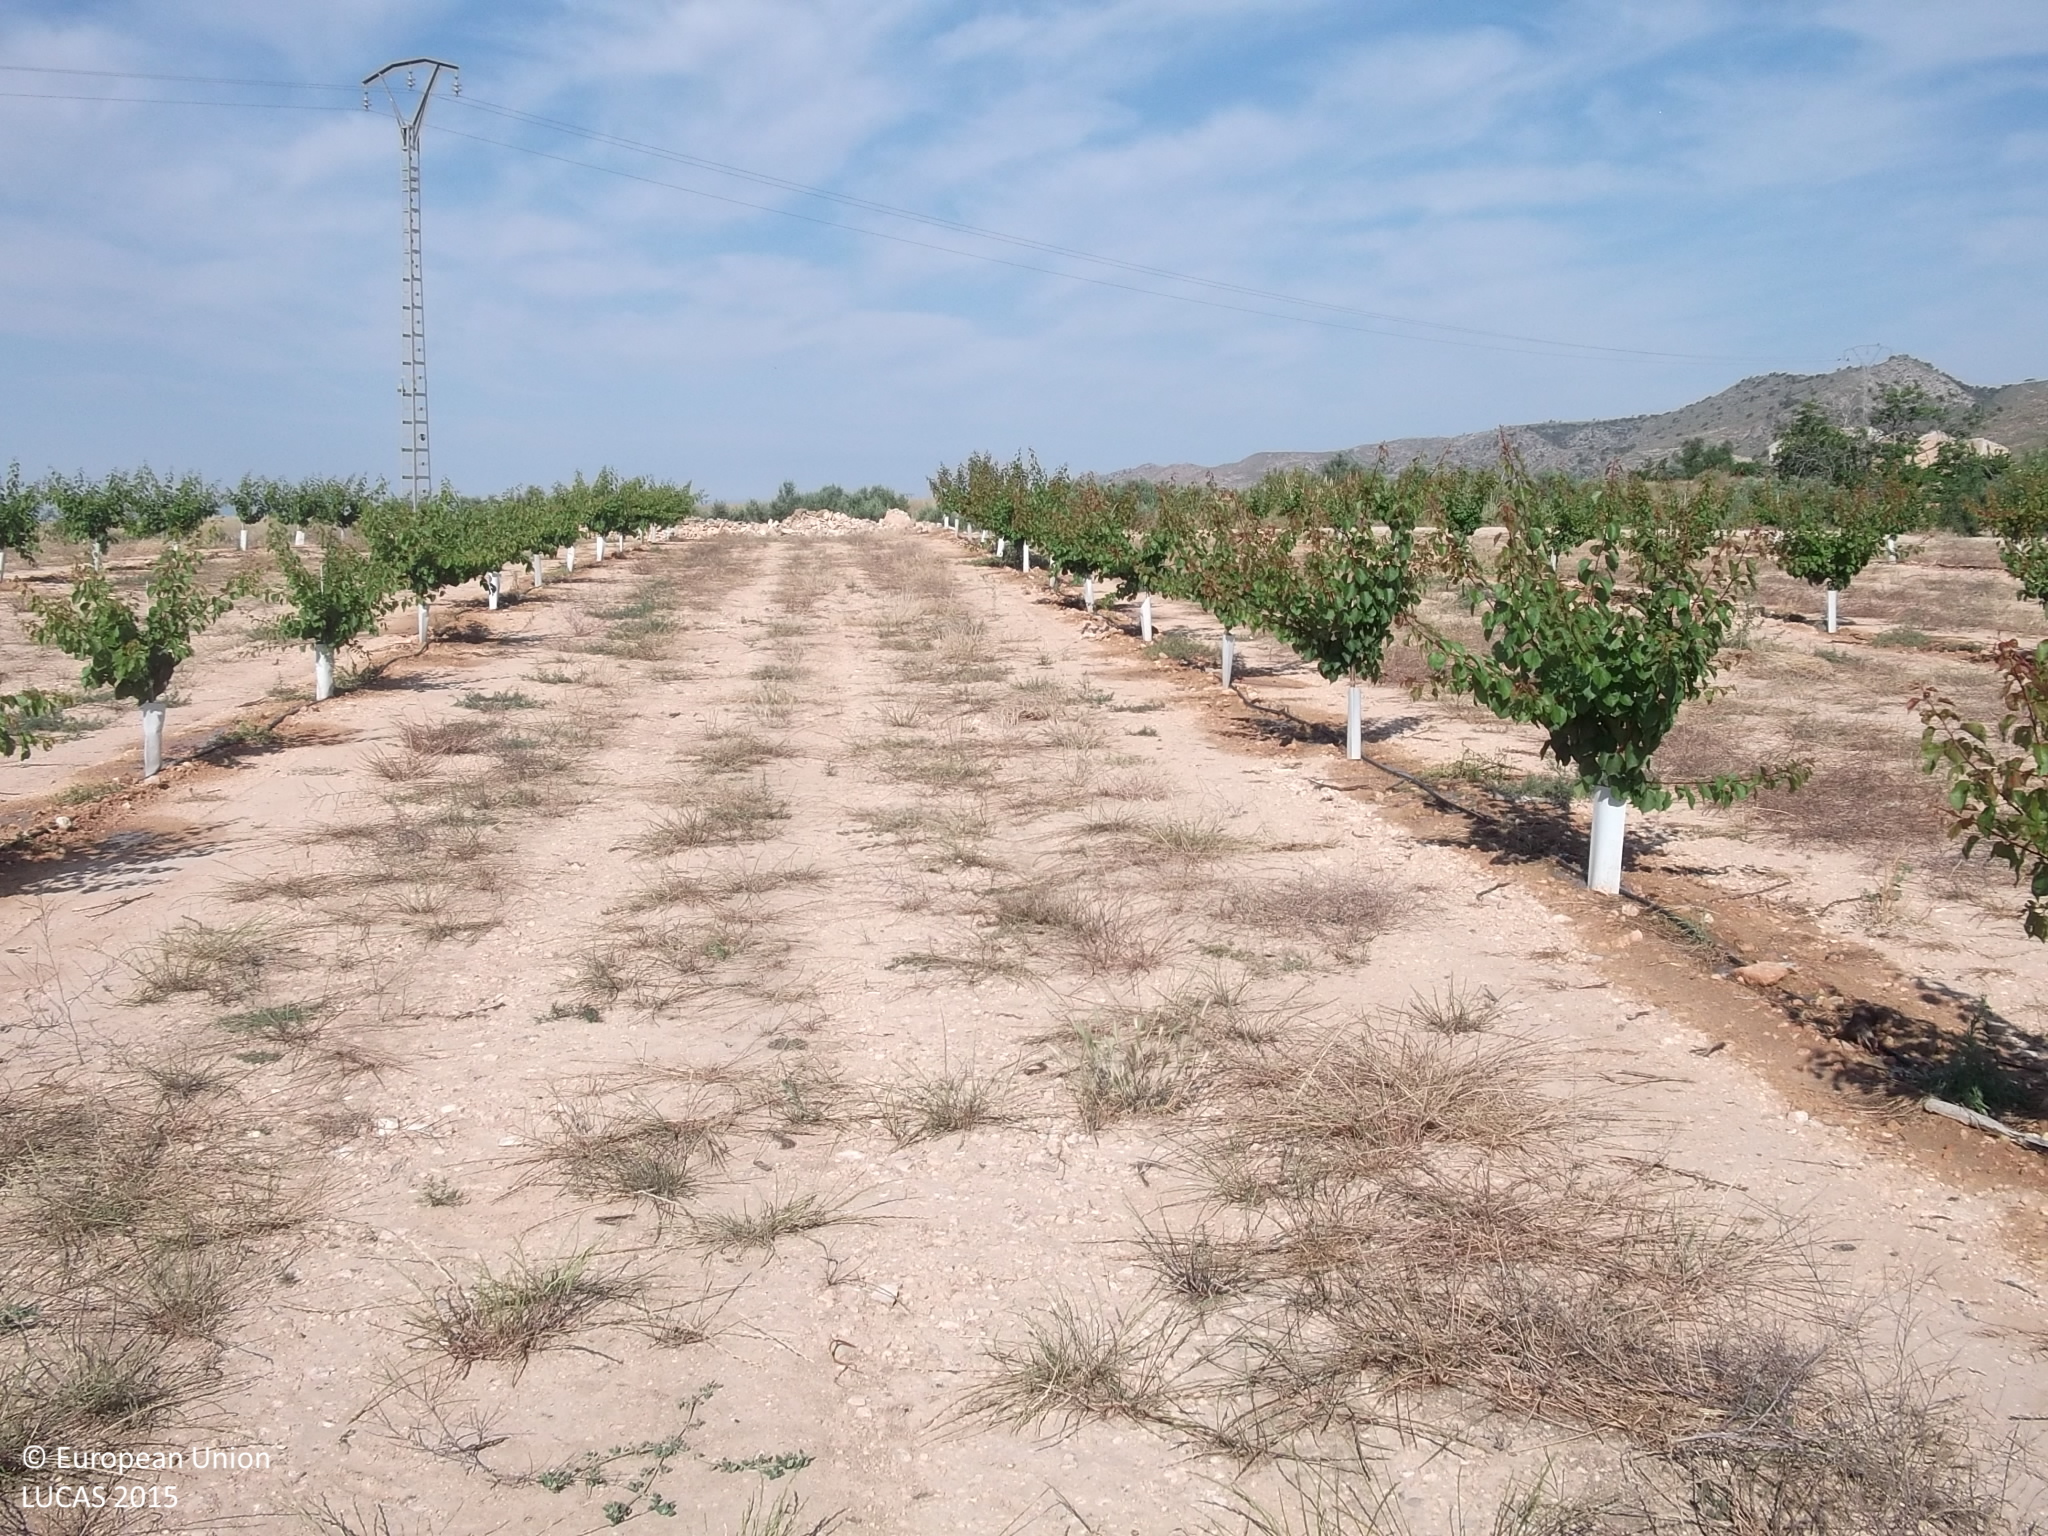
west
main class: Cropland
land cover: Other fruit trees and berries
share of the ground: 10 - 25 %
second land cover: Spontaneously vegetated surfaces
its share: > 75 %
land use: Agriculture (excluding fallow land and kitchen gardens)
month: June
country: ES
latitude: 38.4246
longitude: -1.4567
